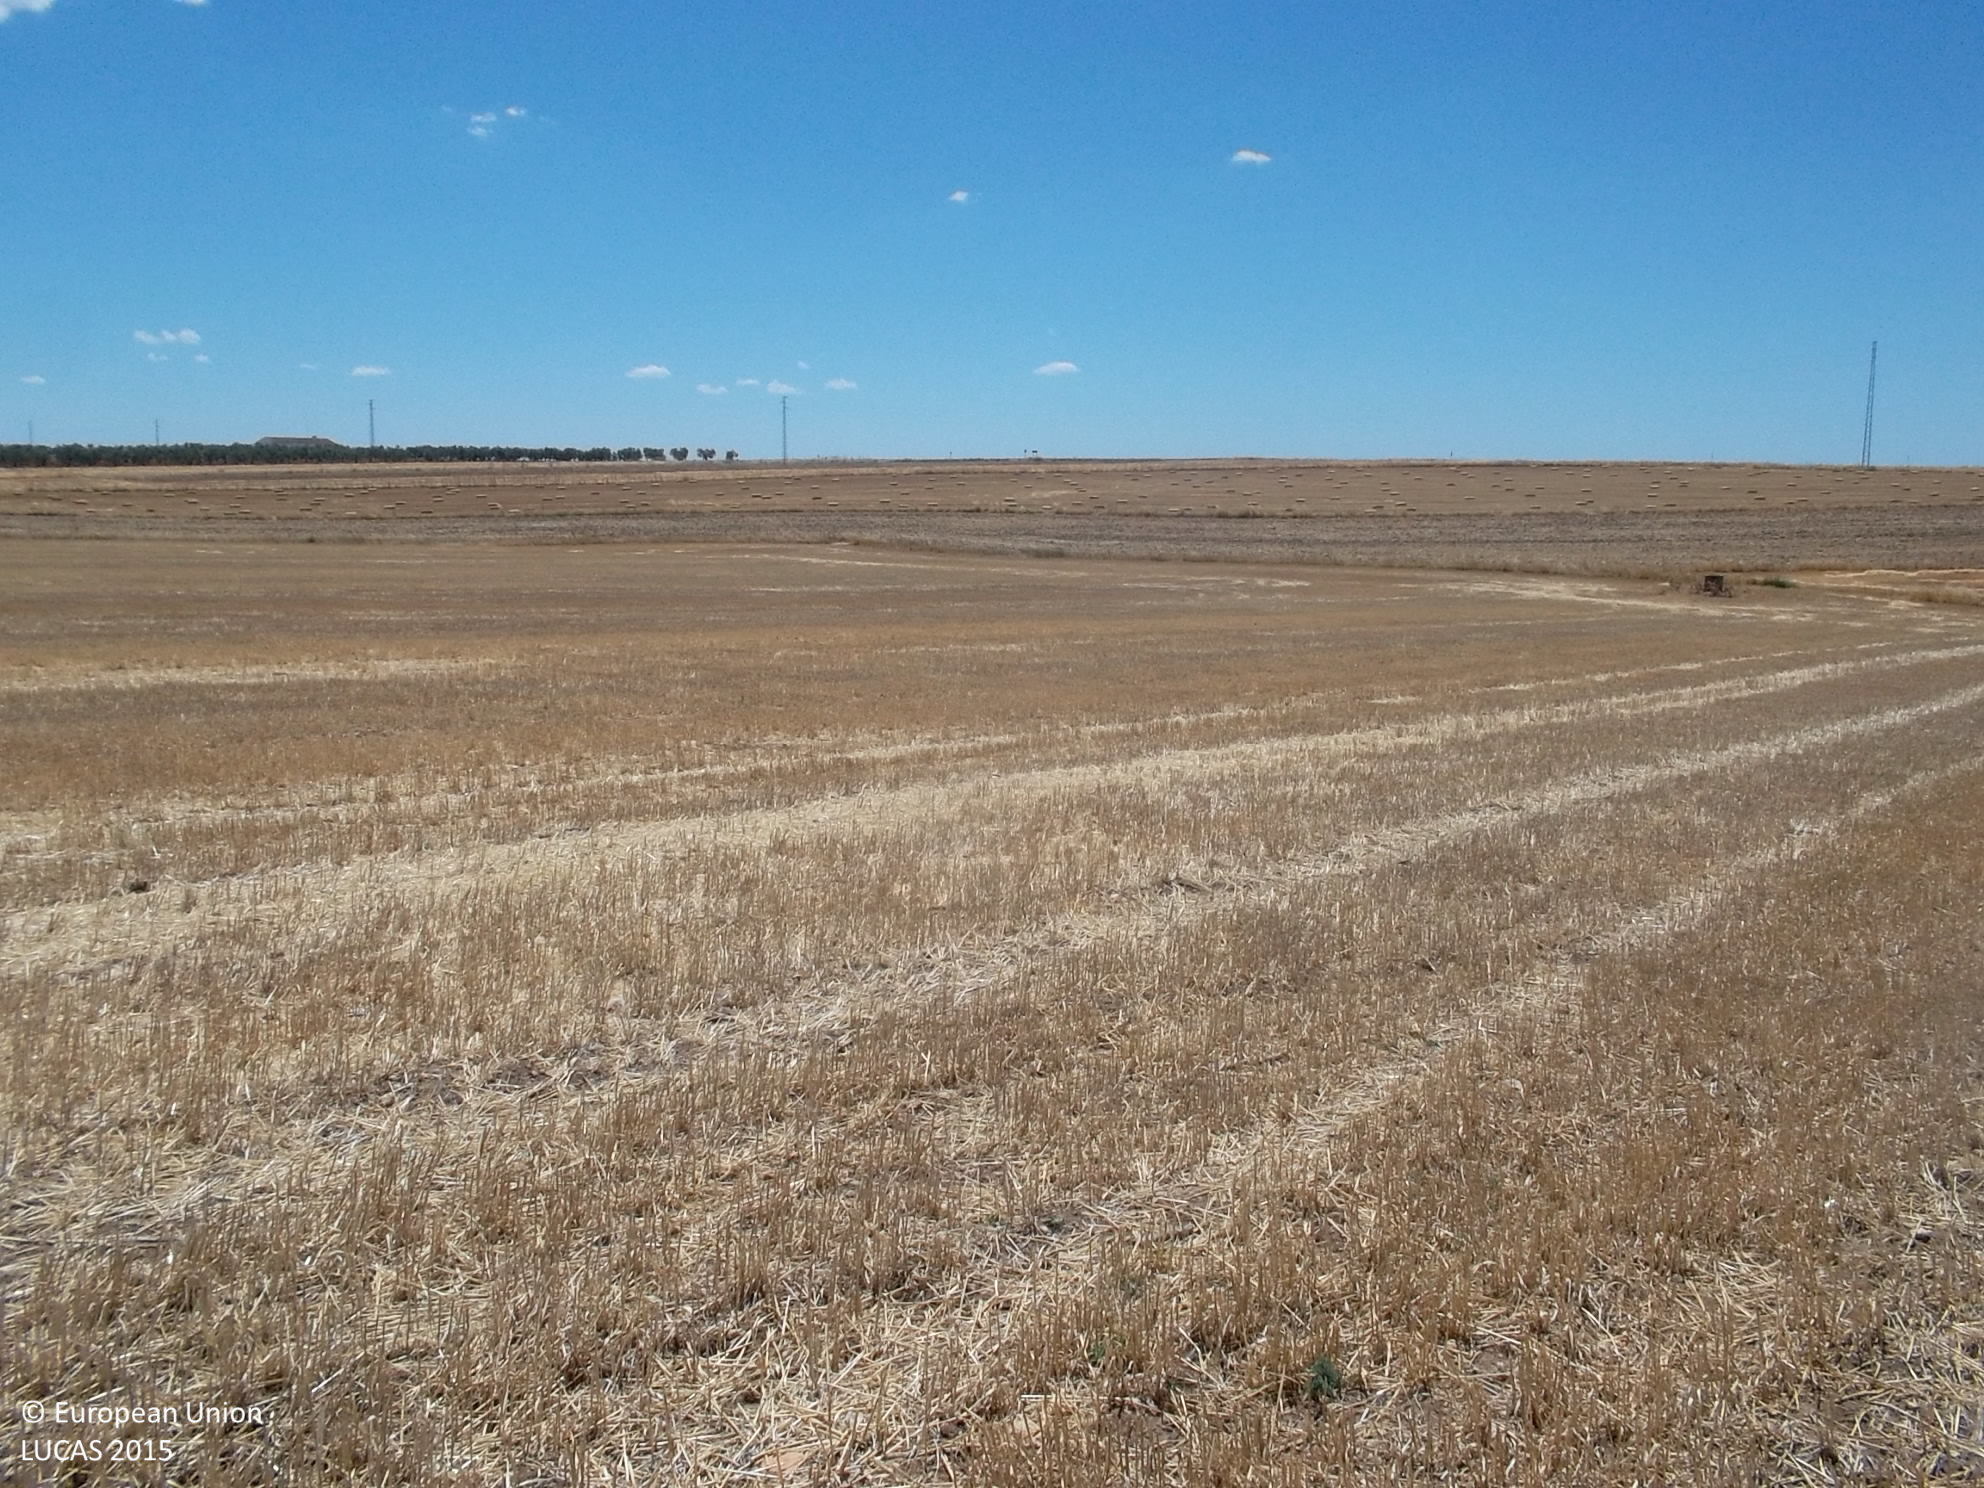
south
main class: Cropland
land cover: Barley
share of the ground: < 10 %
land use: Agriculture (excluding fallow land and kitchen gardens)
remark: Harvested field
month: July
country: ES
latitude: 38.3390
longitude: -5.7684
